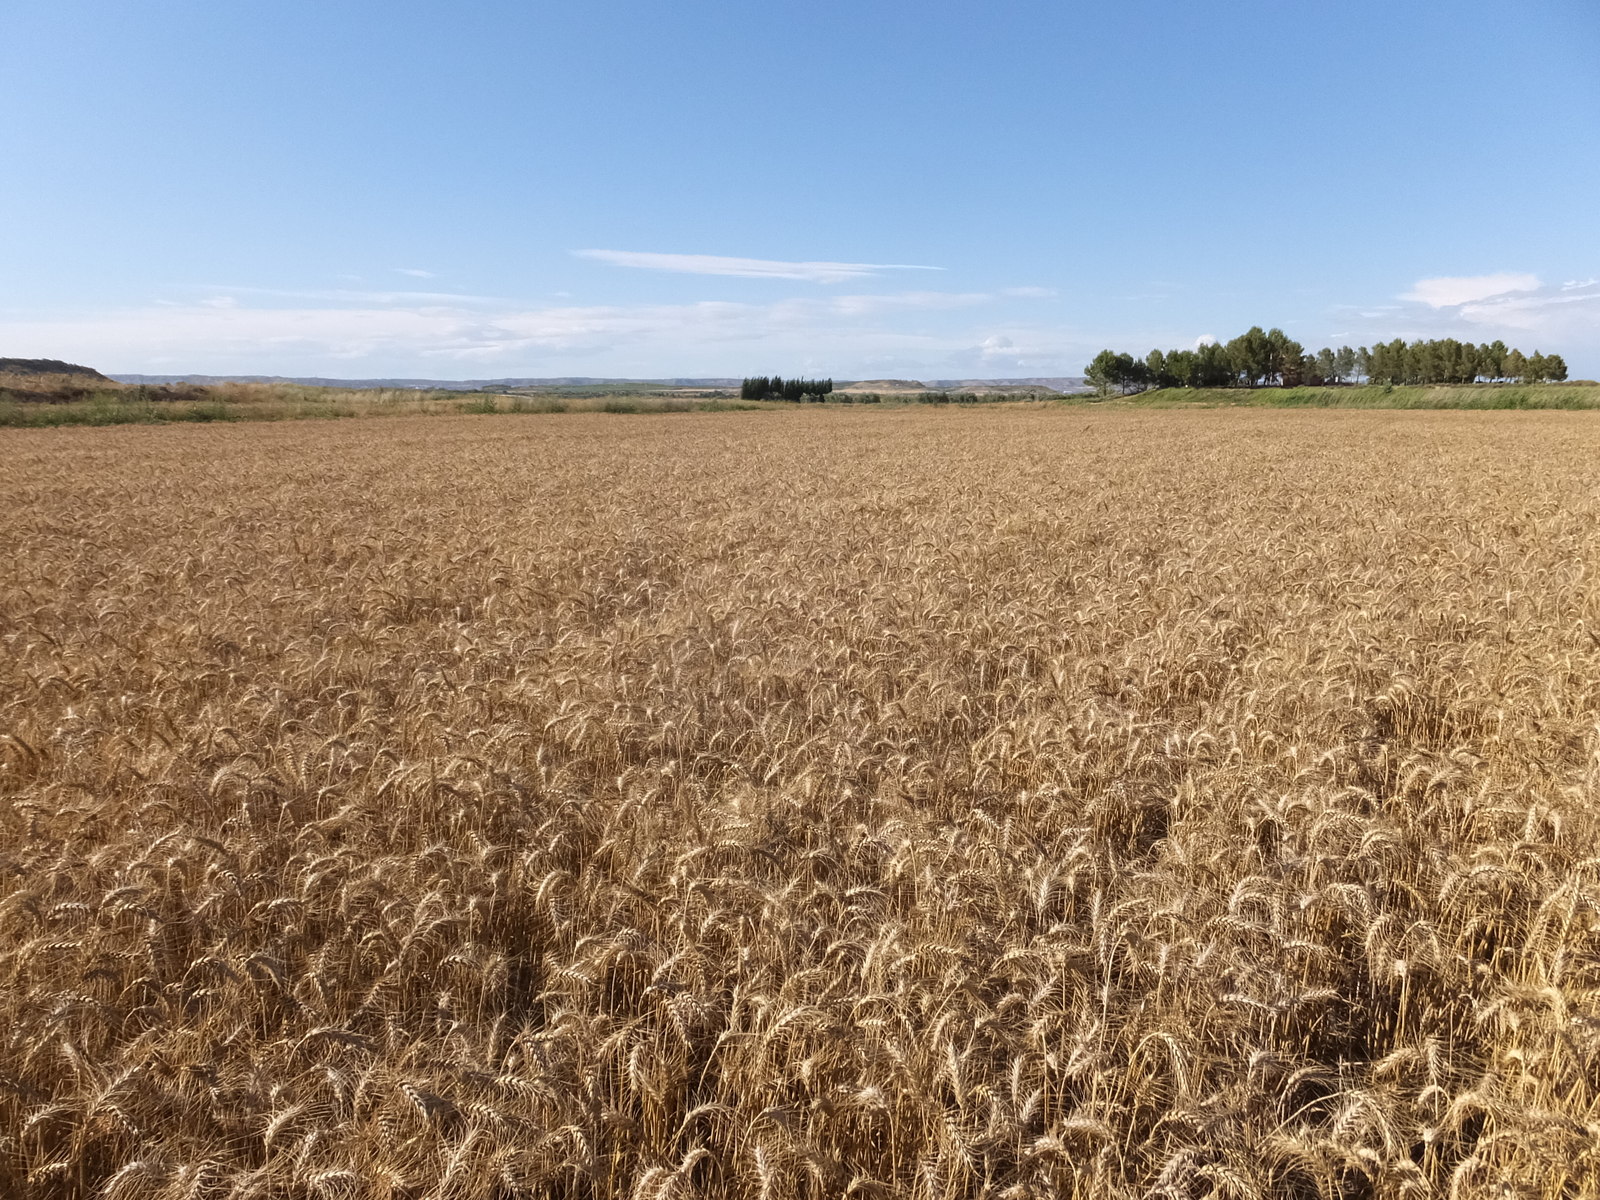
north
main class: Cropland
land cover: Durum wheat
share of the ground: > 75 %
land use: Agriculture (excluding fallow land and kitchen gardens)
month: June
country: ES
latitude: 41.2184
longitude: -0.1158
